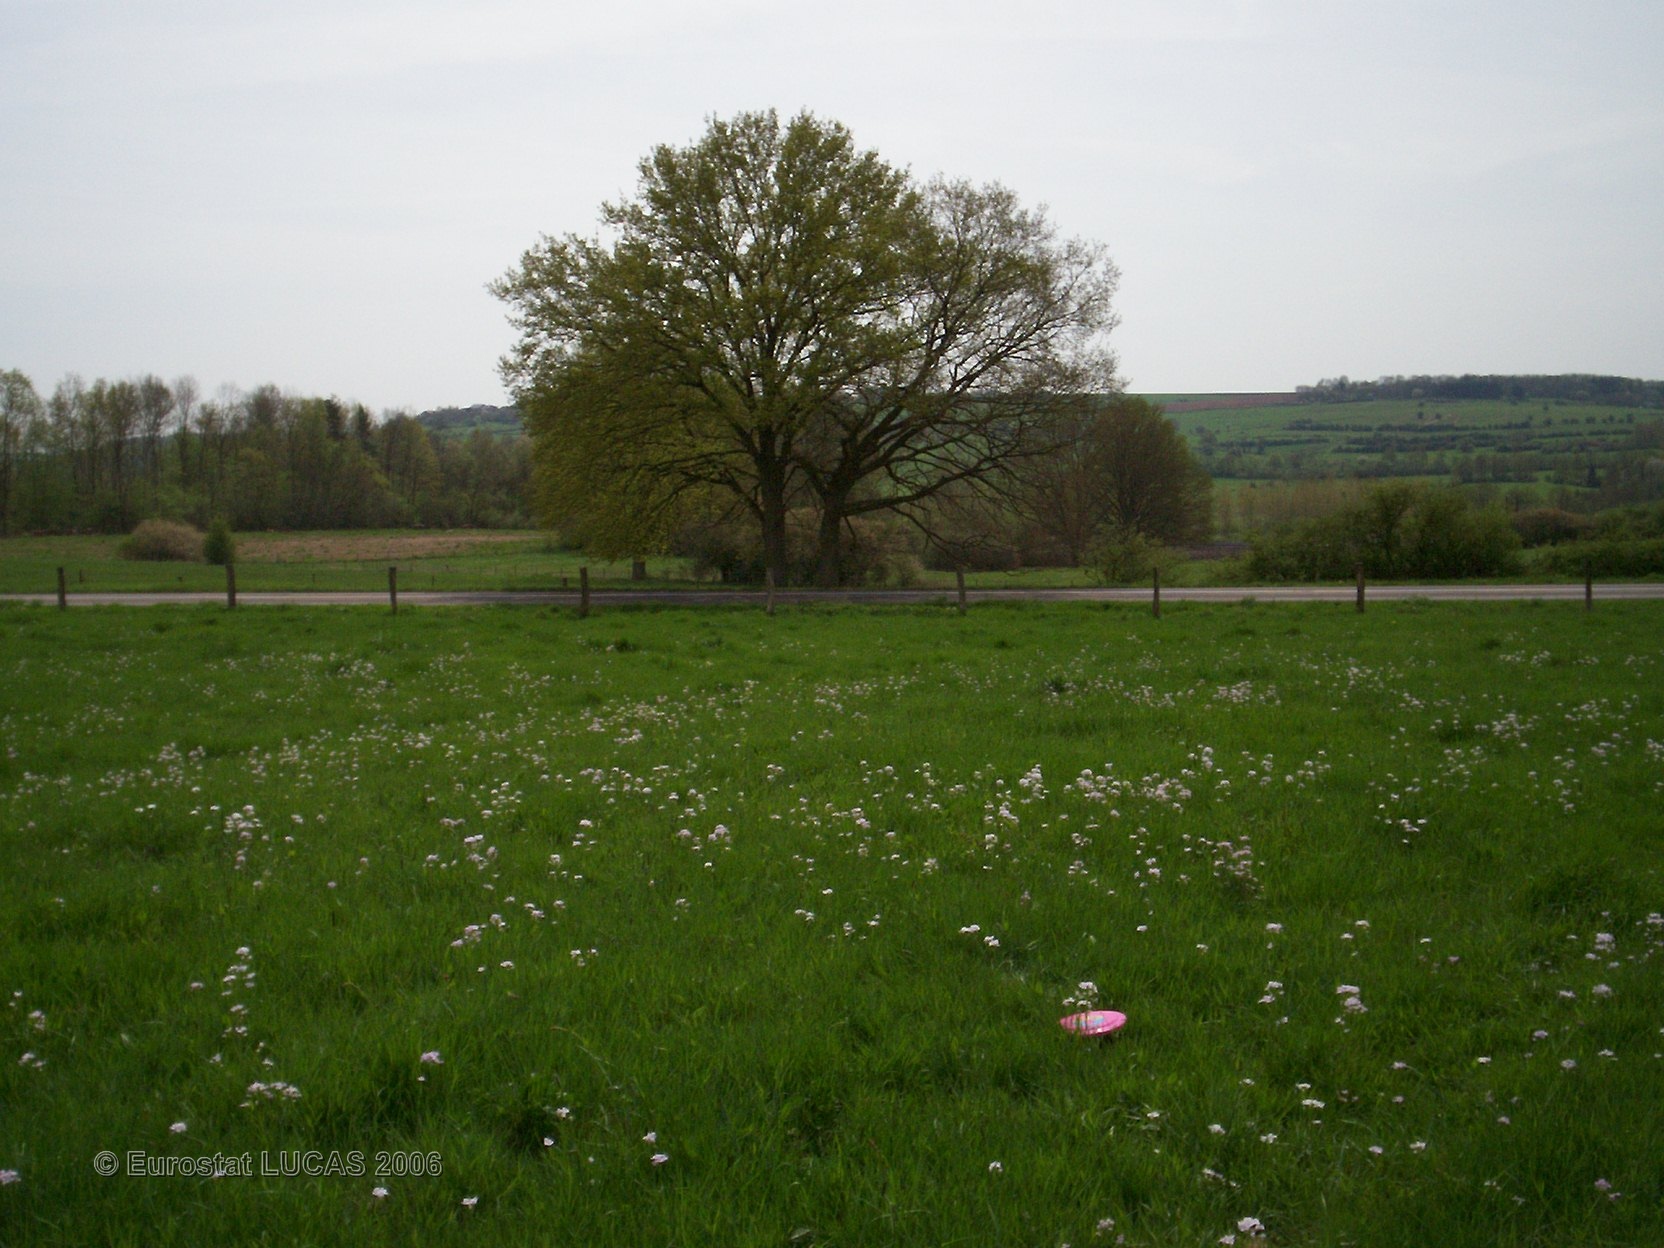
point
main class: Grassland
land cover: Grassland without tree/shrub cover
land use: Agriculture (excluding fallow land and kitchen gardens)
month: May
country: FR
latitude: 49.8009
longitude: 4.5360
